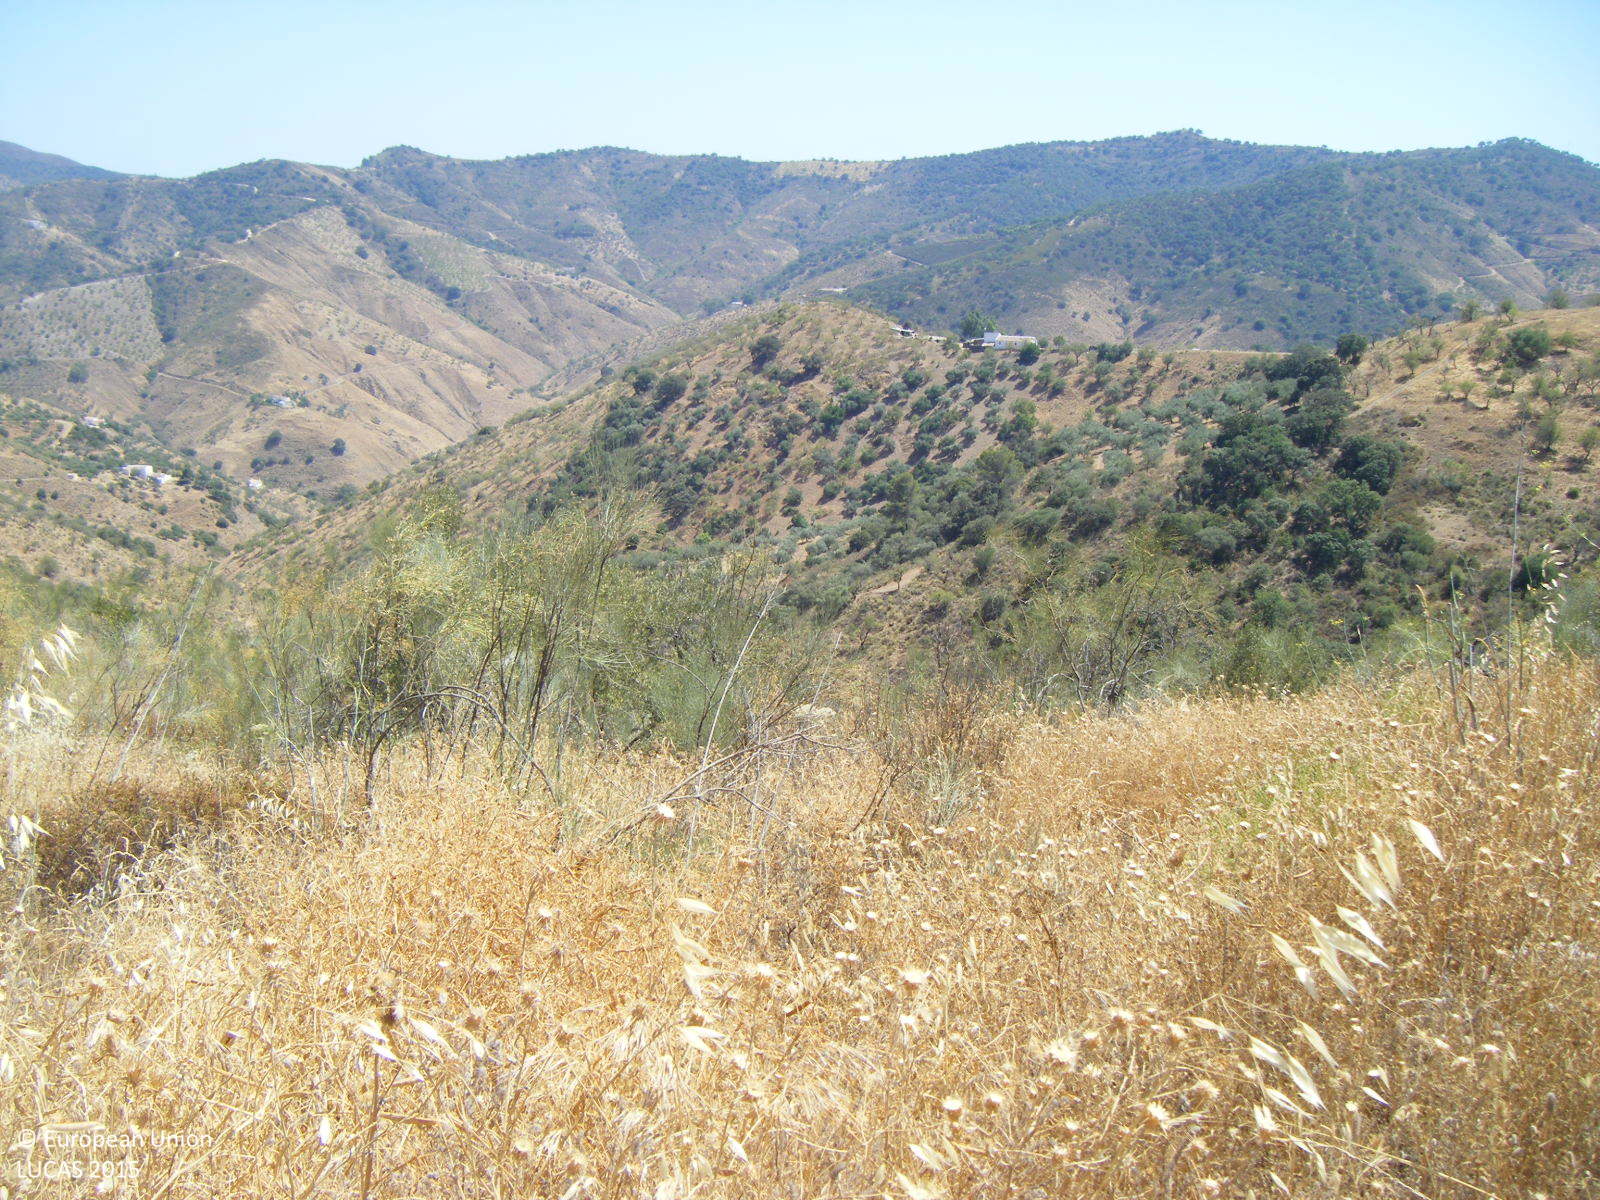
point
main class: Cropland
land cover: Nuts trees
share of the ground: 10 - 25 %
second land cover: Spontaneously vegetated surfaces
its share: > 75 %
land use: Abandoned areas
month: July
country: ES
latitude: 36.8395
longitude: -4.3330
